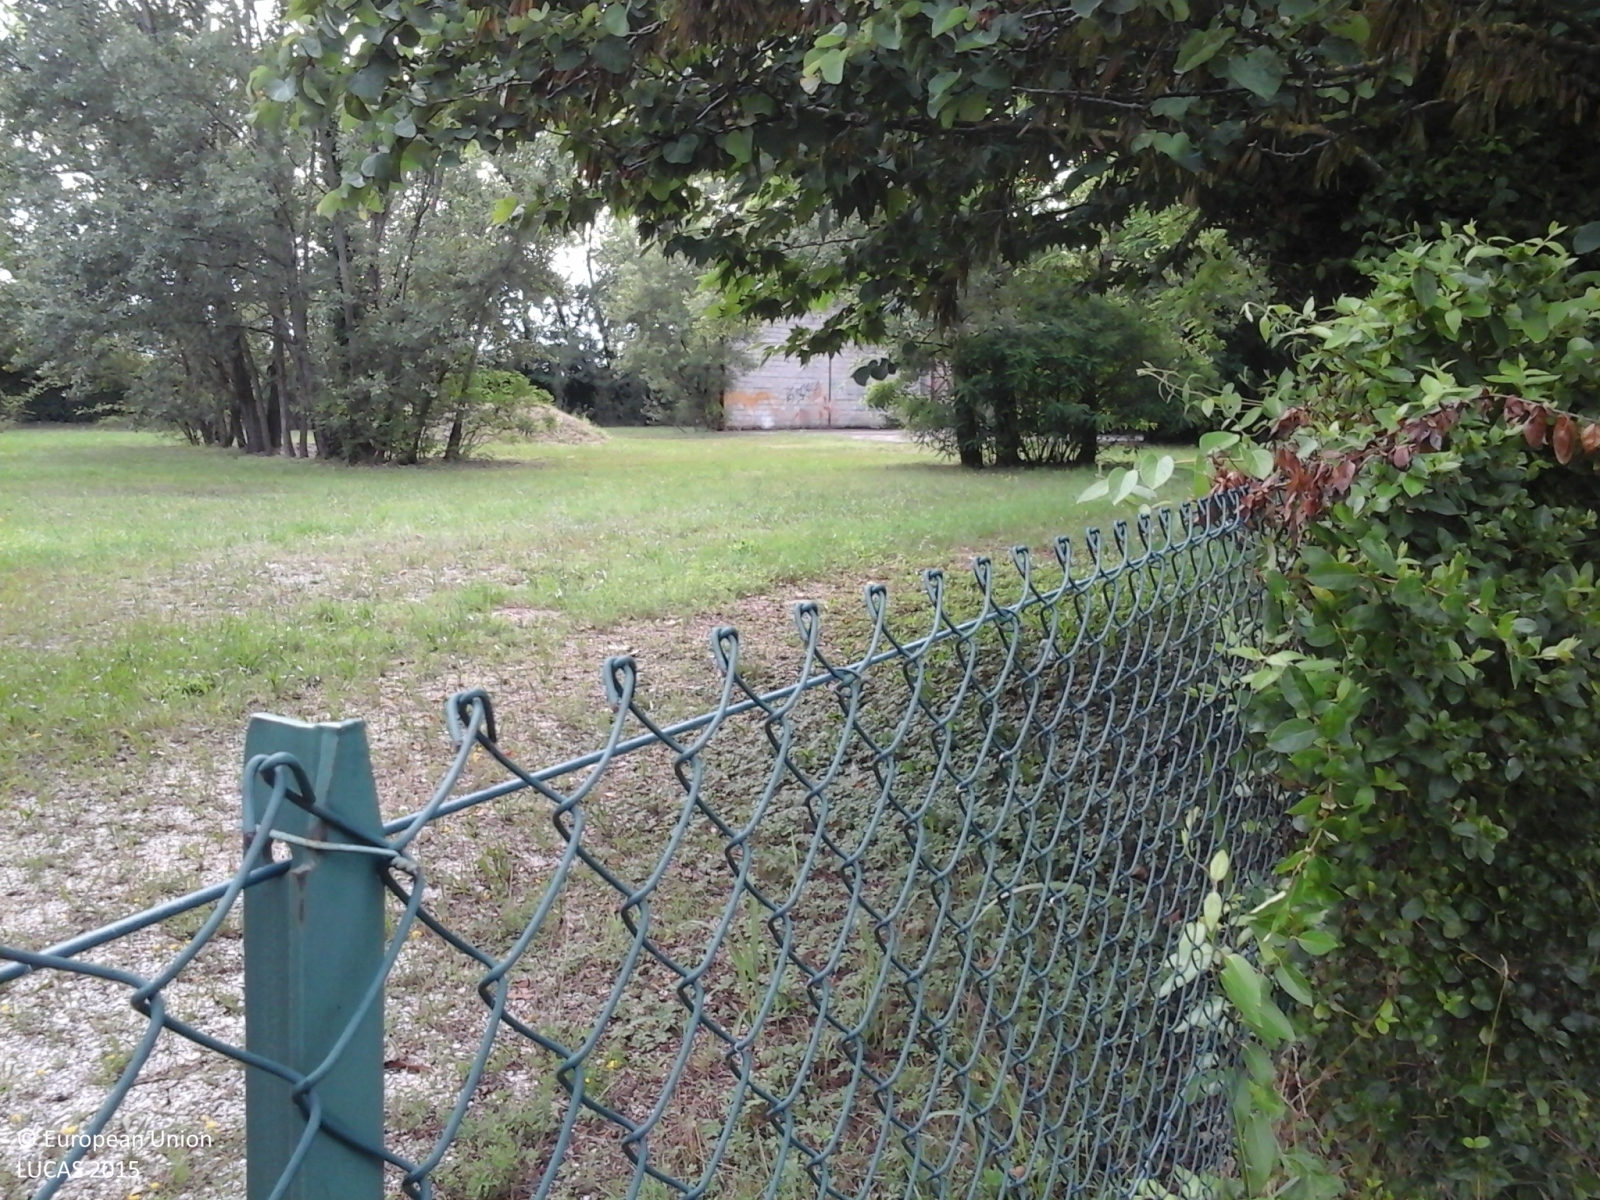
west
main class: Artificial land
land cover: Non built-up linear features
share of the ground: > 75 %
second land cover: Grassland without tree/shrub cover
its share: 10 - 25 %
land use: Road transport
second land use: Agriculture (excluding fallow land and kitchen gardens)
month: June
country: IT
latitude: 45.7673
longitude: 12.3241
